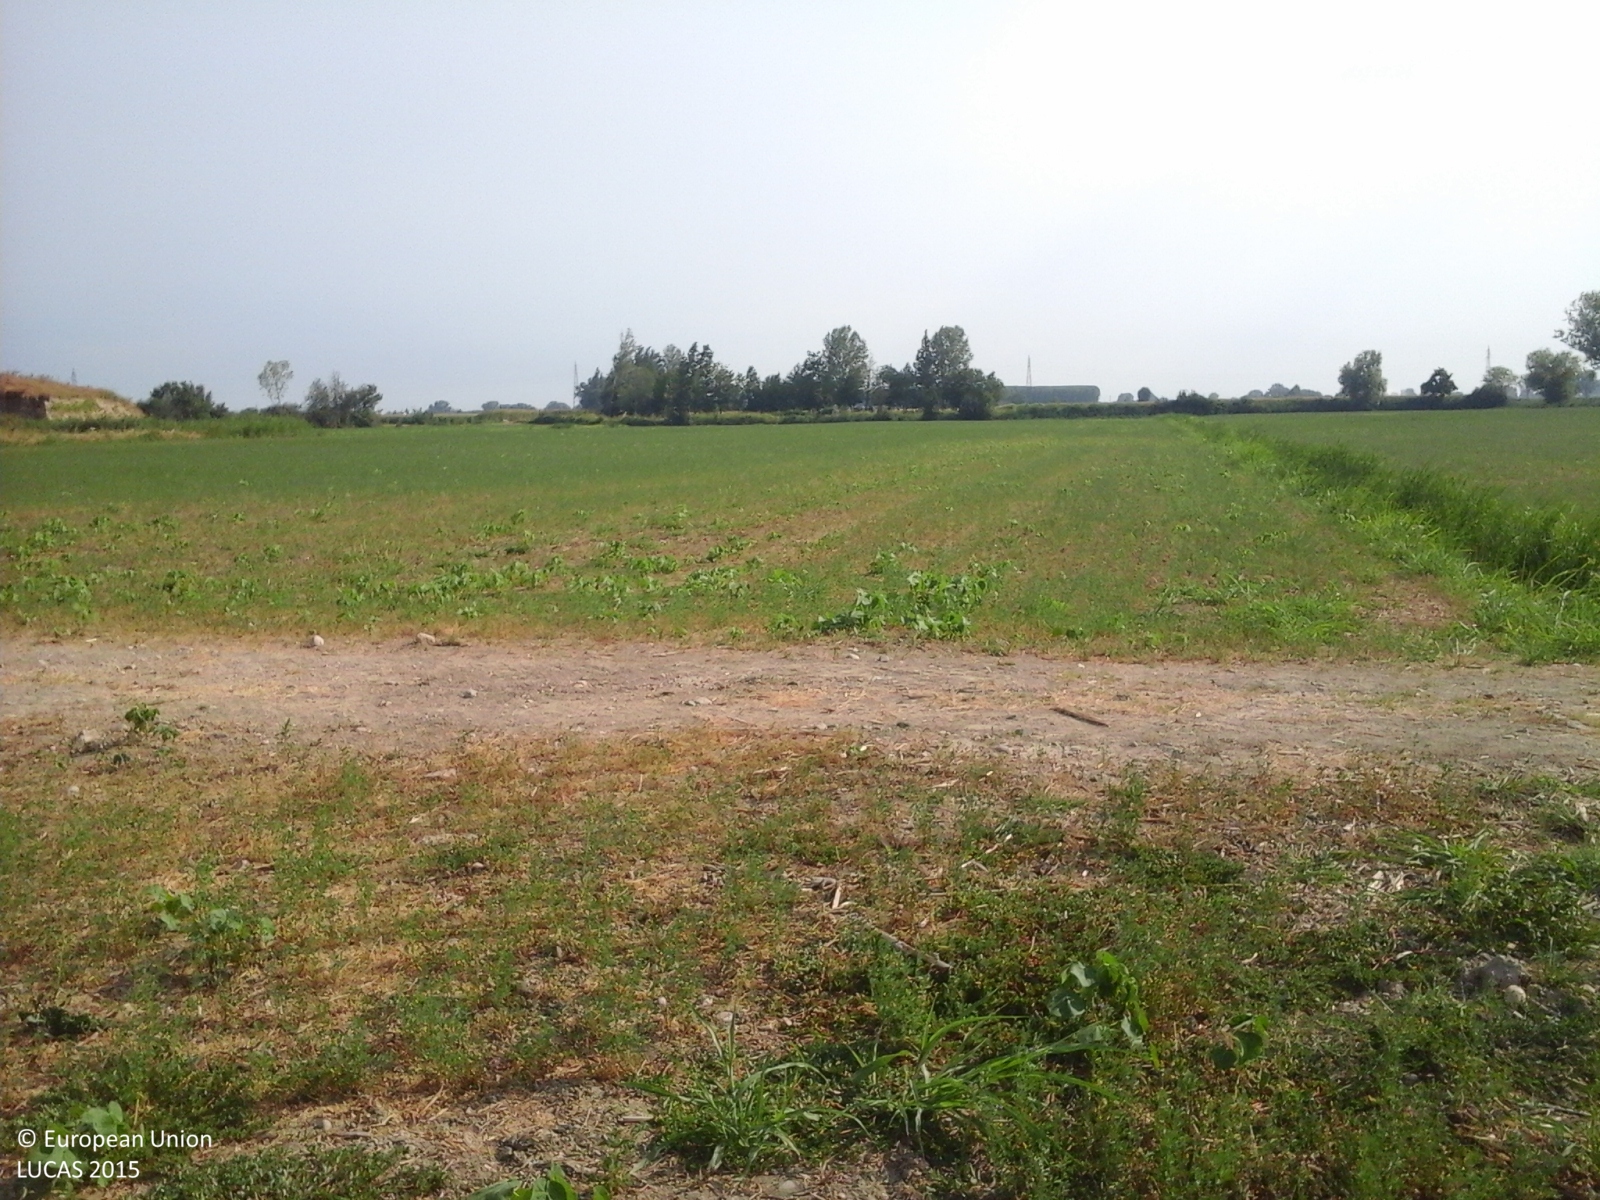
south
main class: Cropland
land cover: Lucerne
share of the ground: 25 - 50 %
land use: Agriculture (excluding fallow land and kitchen gardens)
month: July
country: IT
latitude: 44.9426
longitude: 10.7968
